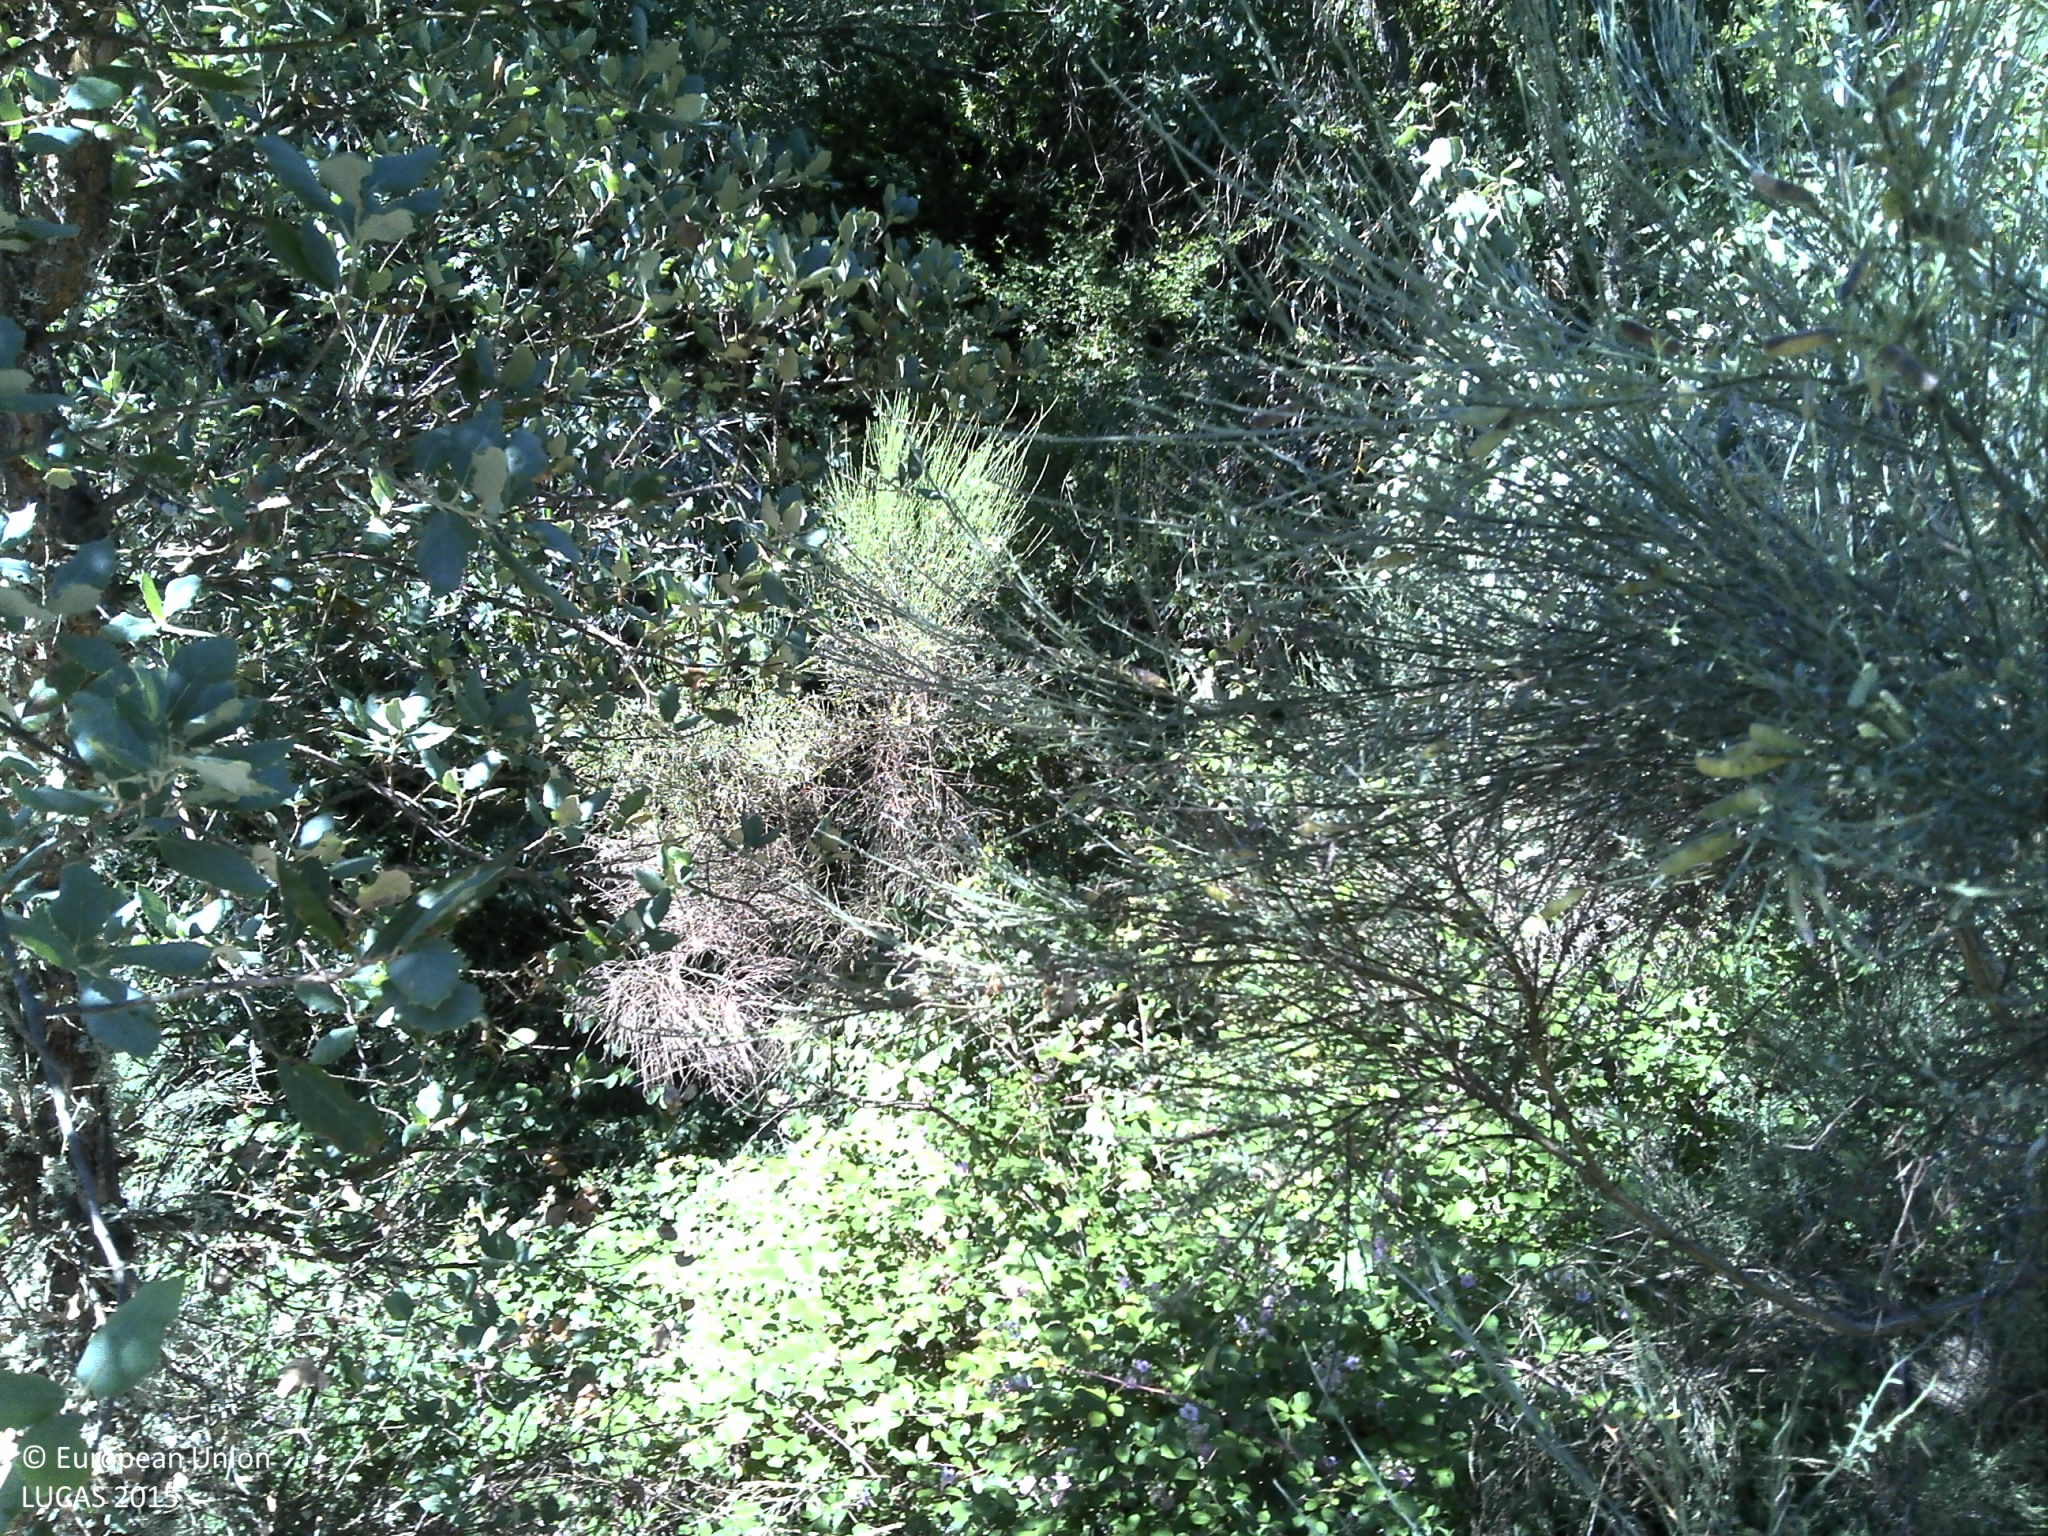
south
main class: Shrubland
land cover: Shrubland with sparse tree cover
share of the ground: > 75 %
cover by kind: shrubs 95 %, broadleaved forest trees 5 %
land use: Semi-natural and natural areas not in use
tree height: > 5 m
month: June
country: PT
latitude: 41.4461
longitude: -6.8802
